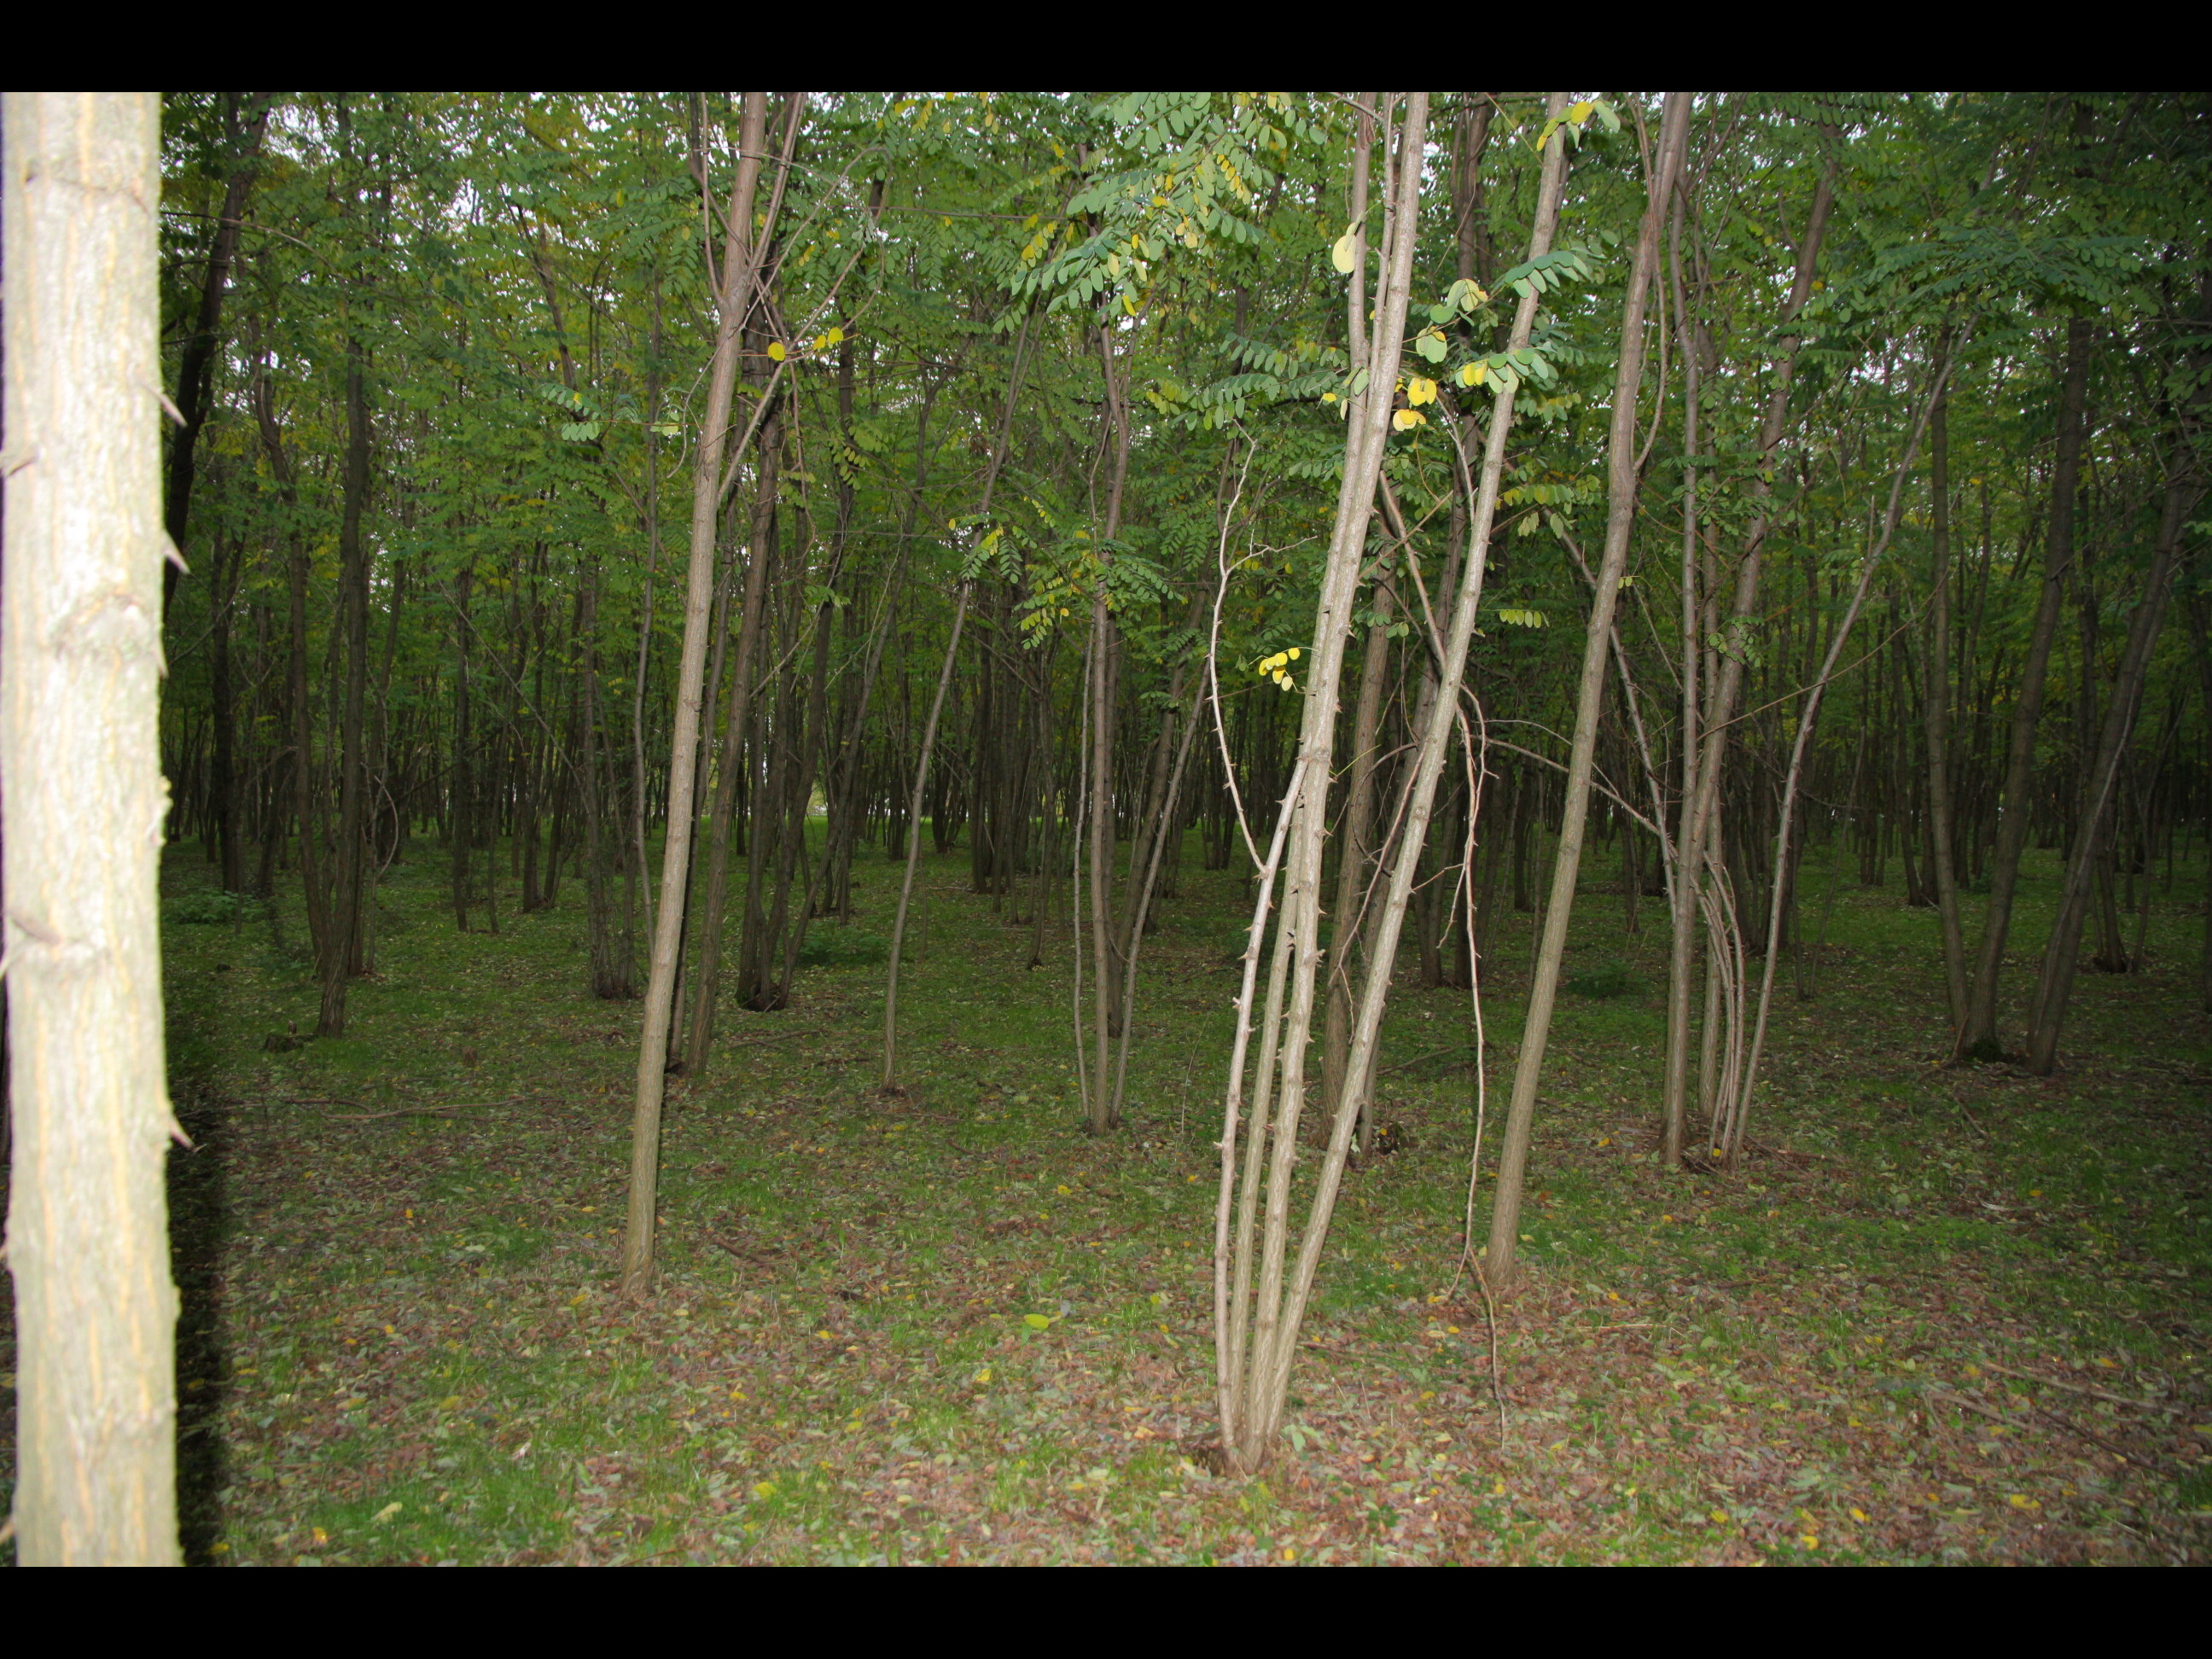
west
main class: Woodland
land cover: Broadleaved woodland
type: thermophilous deciduous forest
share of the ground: > 75 %
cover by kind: broadleaved forest trees 100 %
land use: Forestry
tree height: > 5 m
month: October
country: BG
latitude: 43.6808
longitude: 27.0532
